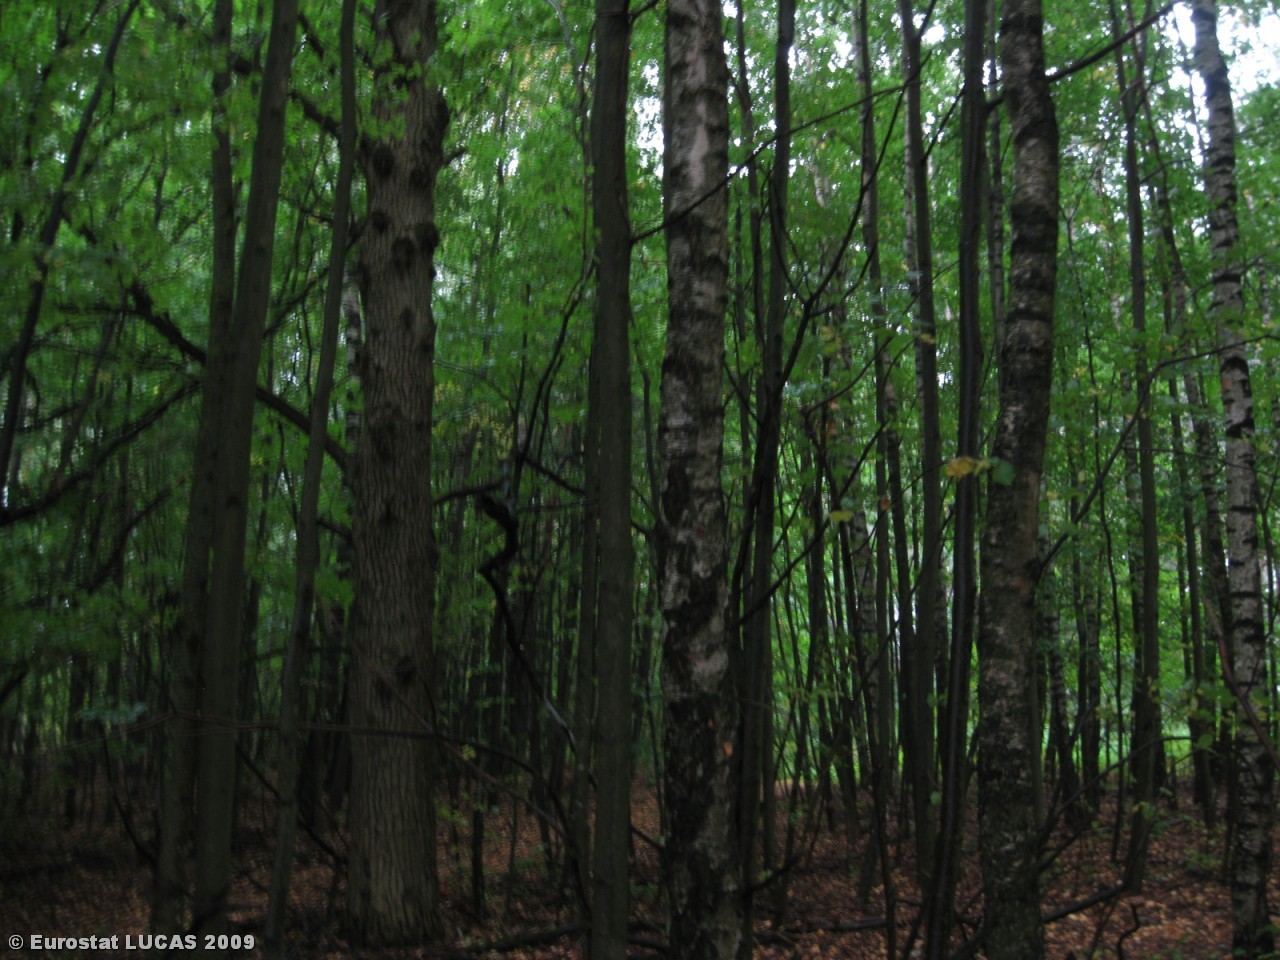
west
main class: Woodland
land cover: Mixed woodland
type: hemiboreal forest and nemoral coniferous forest and mixed broadleaved-coniferous forest
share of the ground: > 75 %
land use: Forestry
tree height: > 5 m
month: September
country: LT
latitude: 54.4226
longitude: 24.6717
